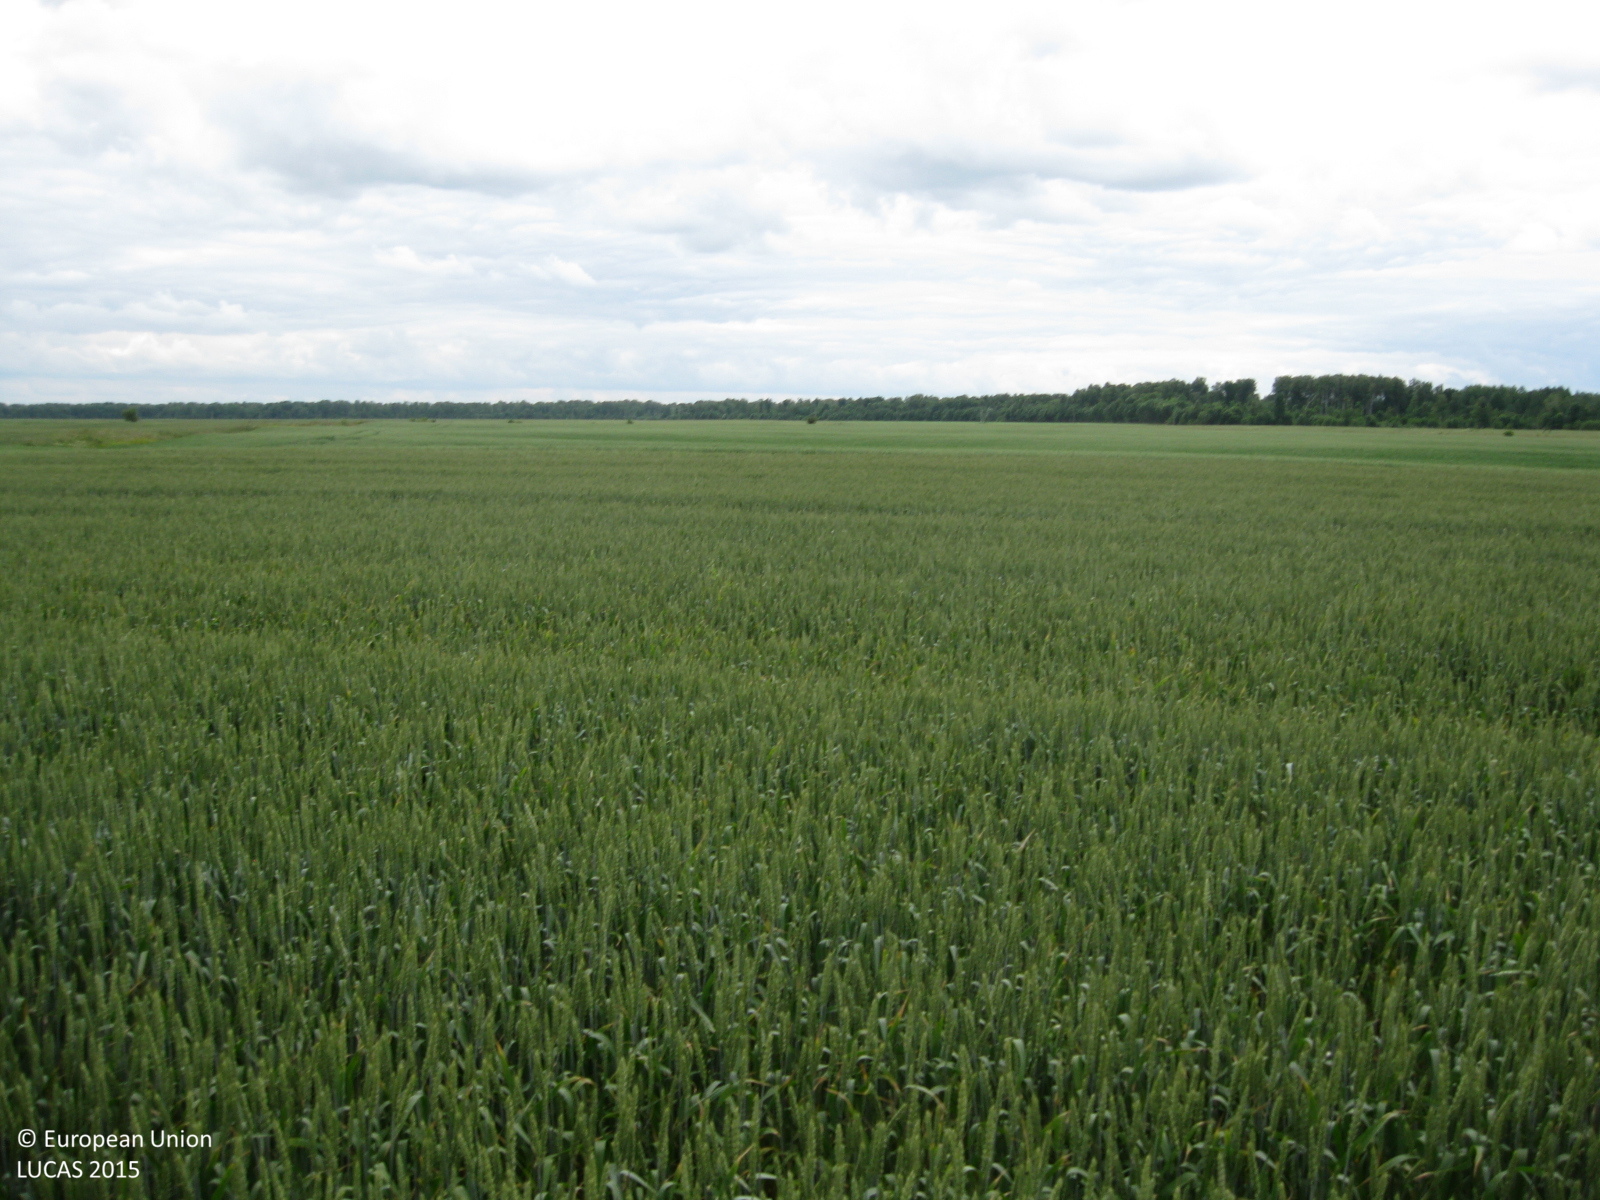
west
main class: Cropland
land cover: Common wheat
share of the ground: > 75 %
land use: Agriculture (excluding fallow land and kitchen gardens)
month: June
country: LT
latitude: 55.3476
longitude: 24.1114
